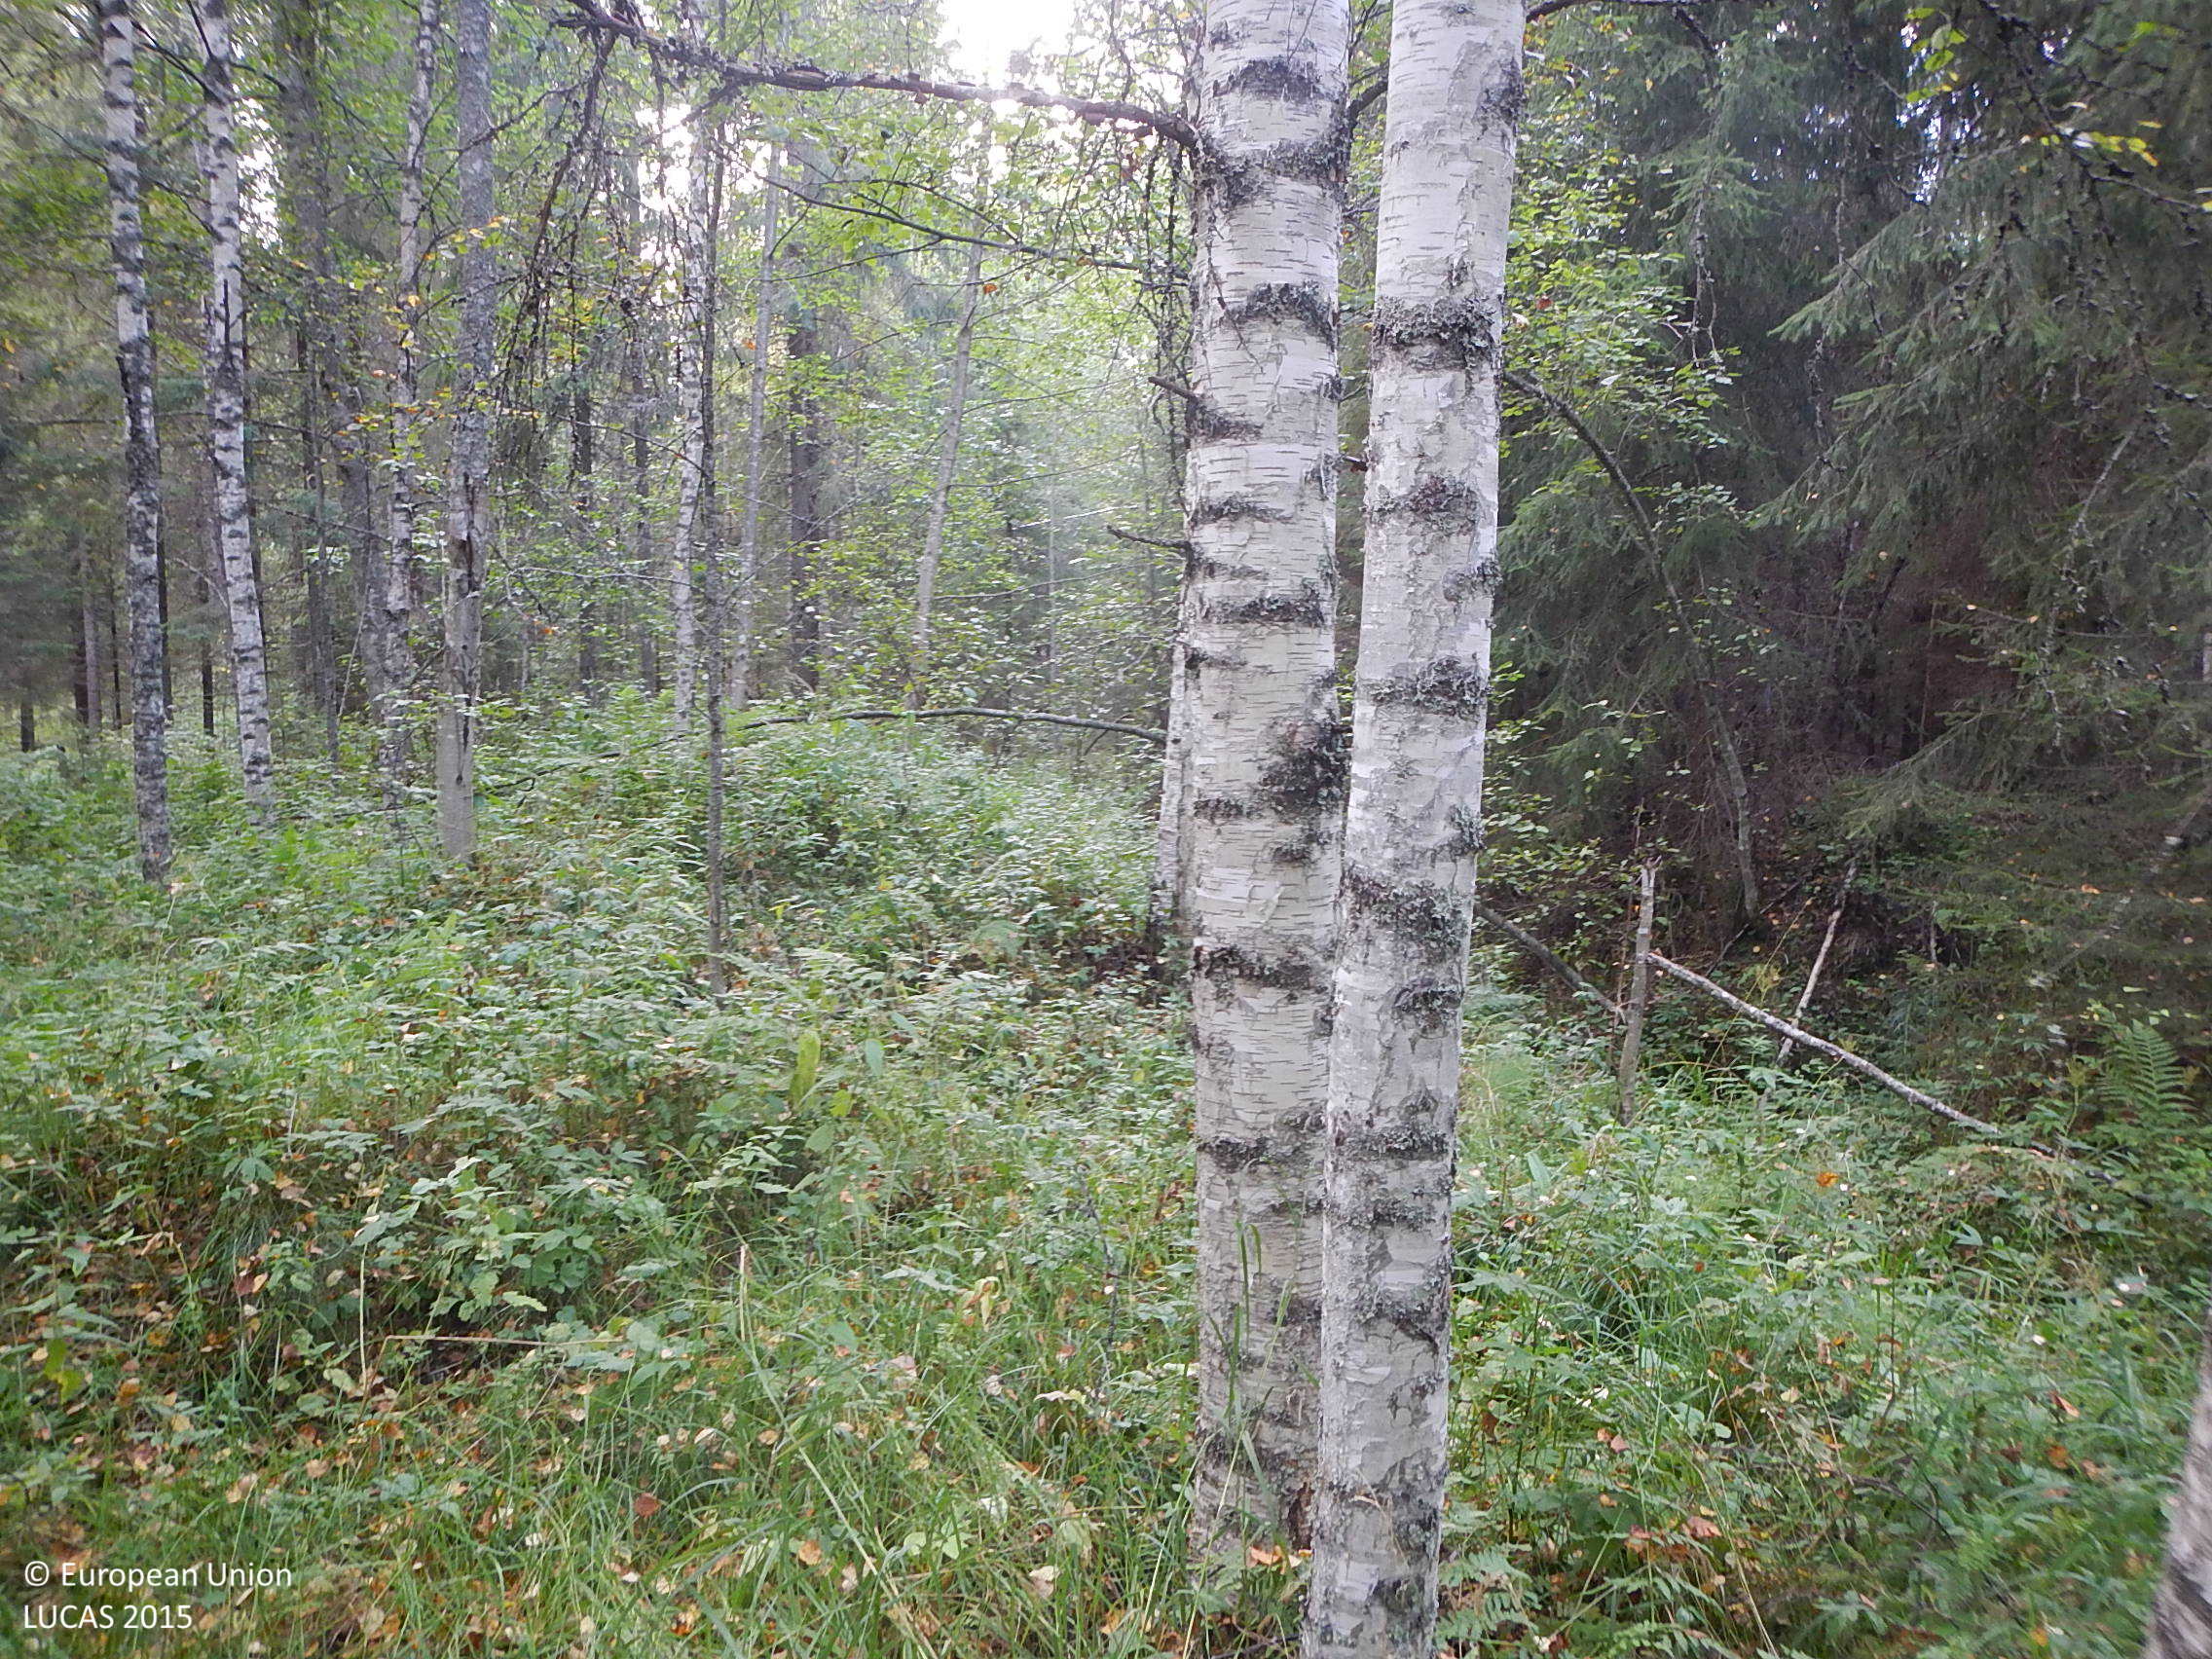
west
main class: Woodland
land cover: Broadleaved woodland
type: non-riverine alder, birch or aspen forest
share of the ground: > 75 %
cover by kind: broadleaved forest trees 75 %, herbaceous plants 20 %, shrubs 5 %
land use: Forestry
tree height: > 5 m
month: September
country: FI
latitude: 61.4657
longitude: 22.0870
